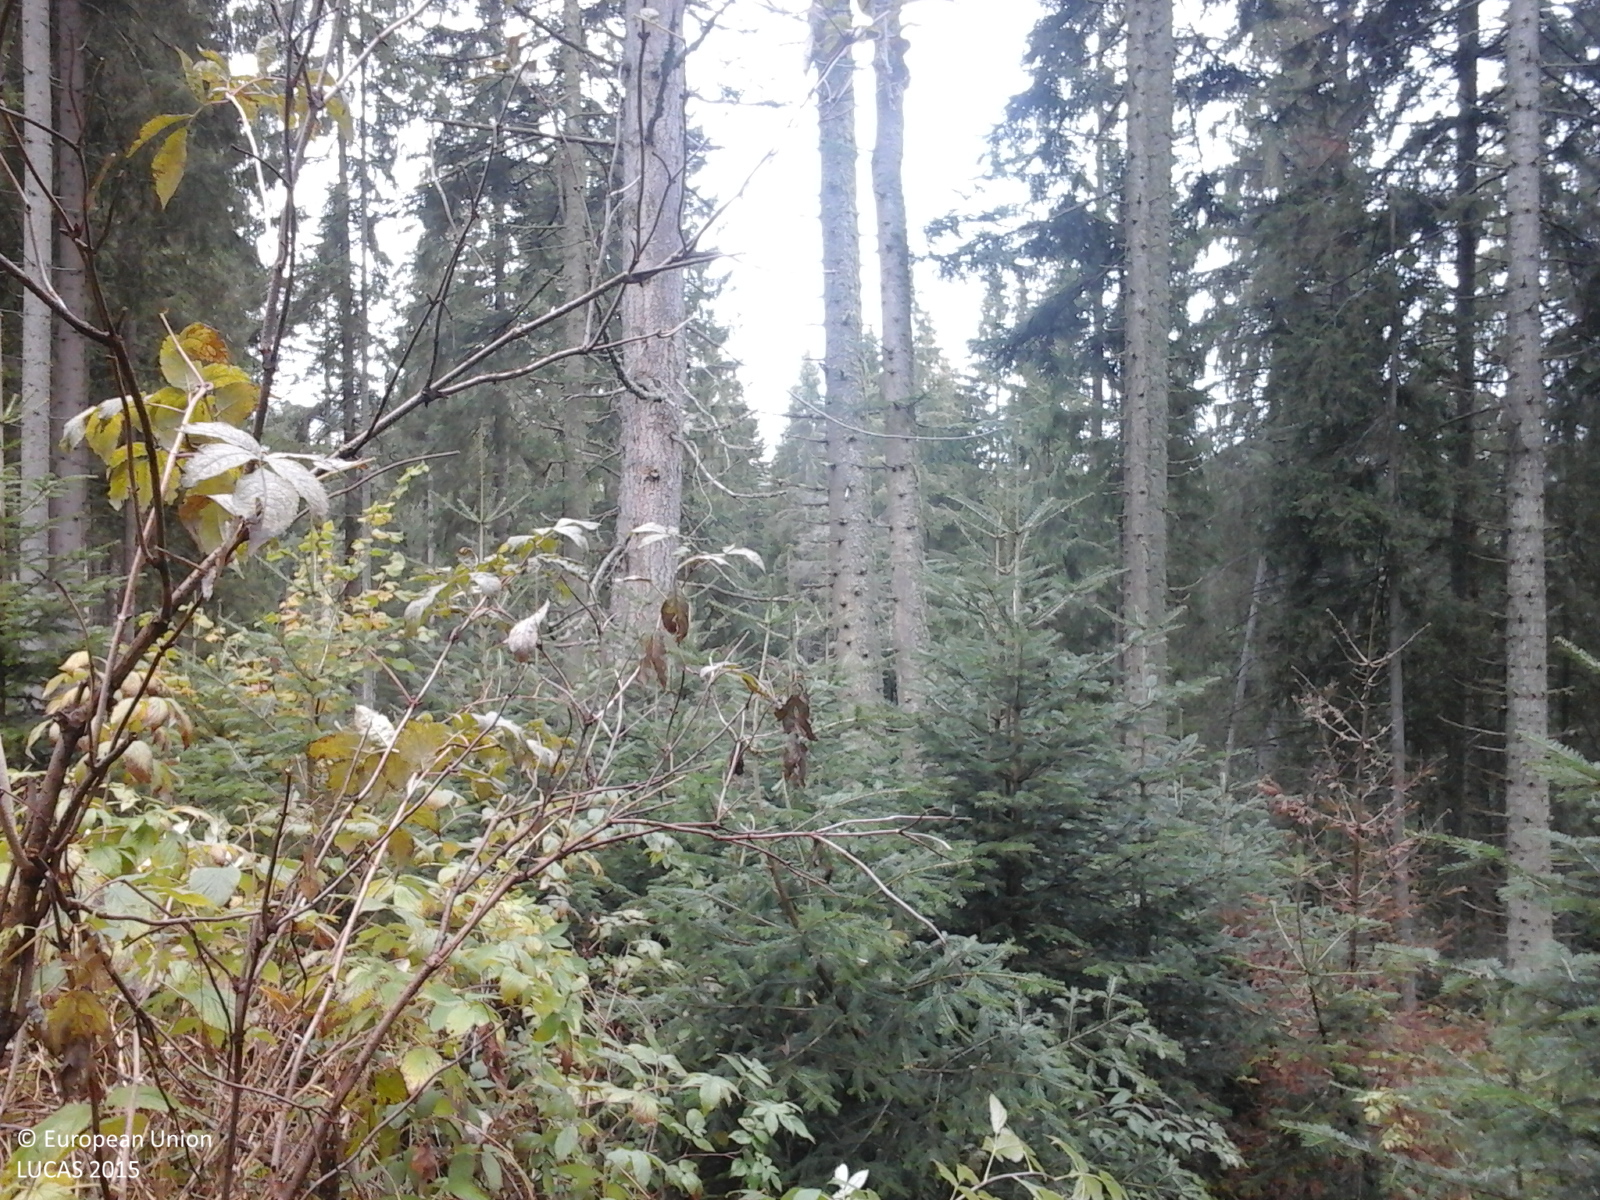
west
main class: Woodland
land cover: Other coniferous woodland
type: alpine coniferous forest
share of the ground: > 75 %
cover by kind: coniferous forest trees 75 %, broadleaved forest trees 10 %, herbaceous plants 10 %, shrubs 5 %
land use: Forestry
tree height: > 5 m
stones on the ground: < 10 %
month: October
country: RO
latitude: 46.8319
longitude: 25.3281
